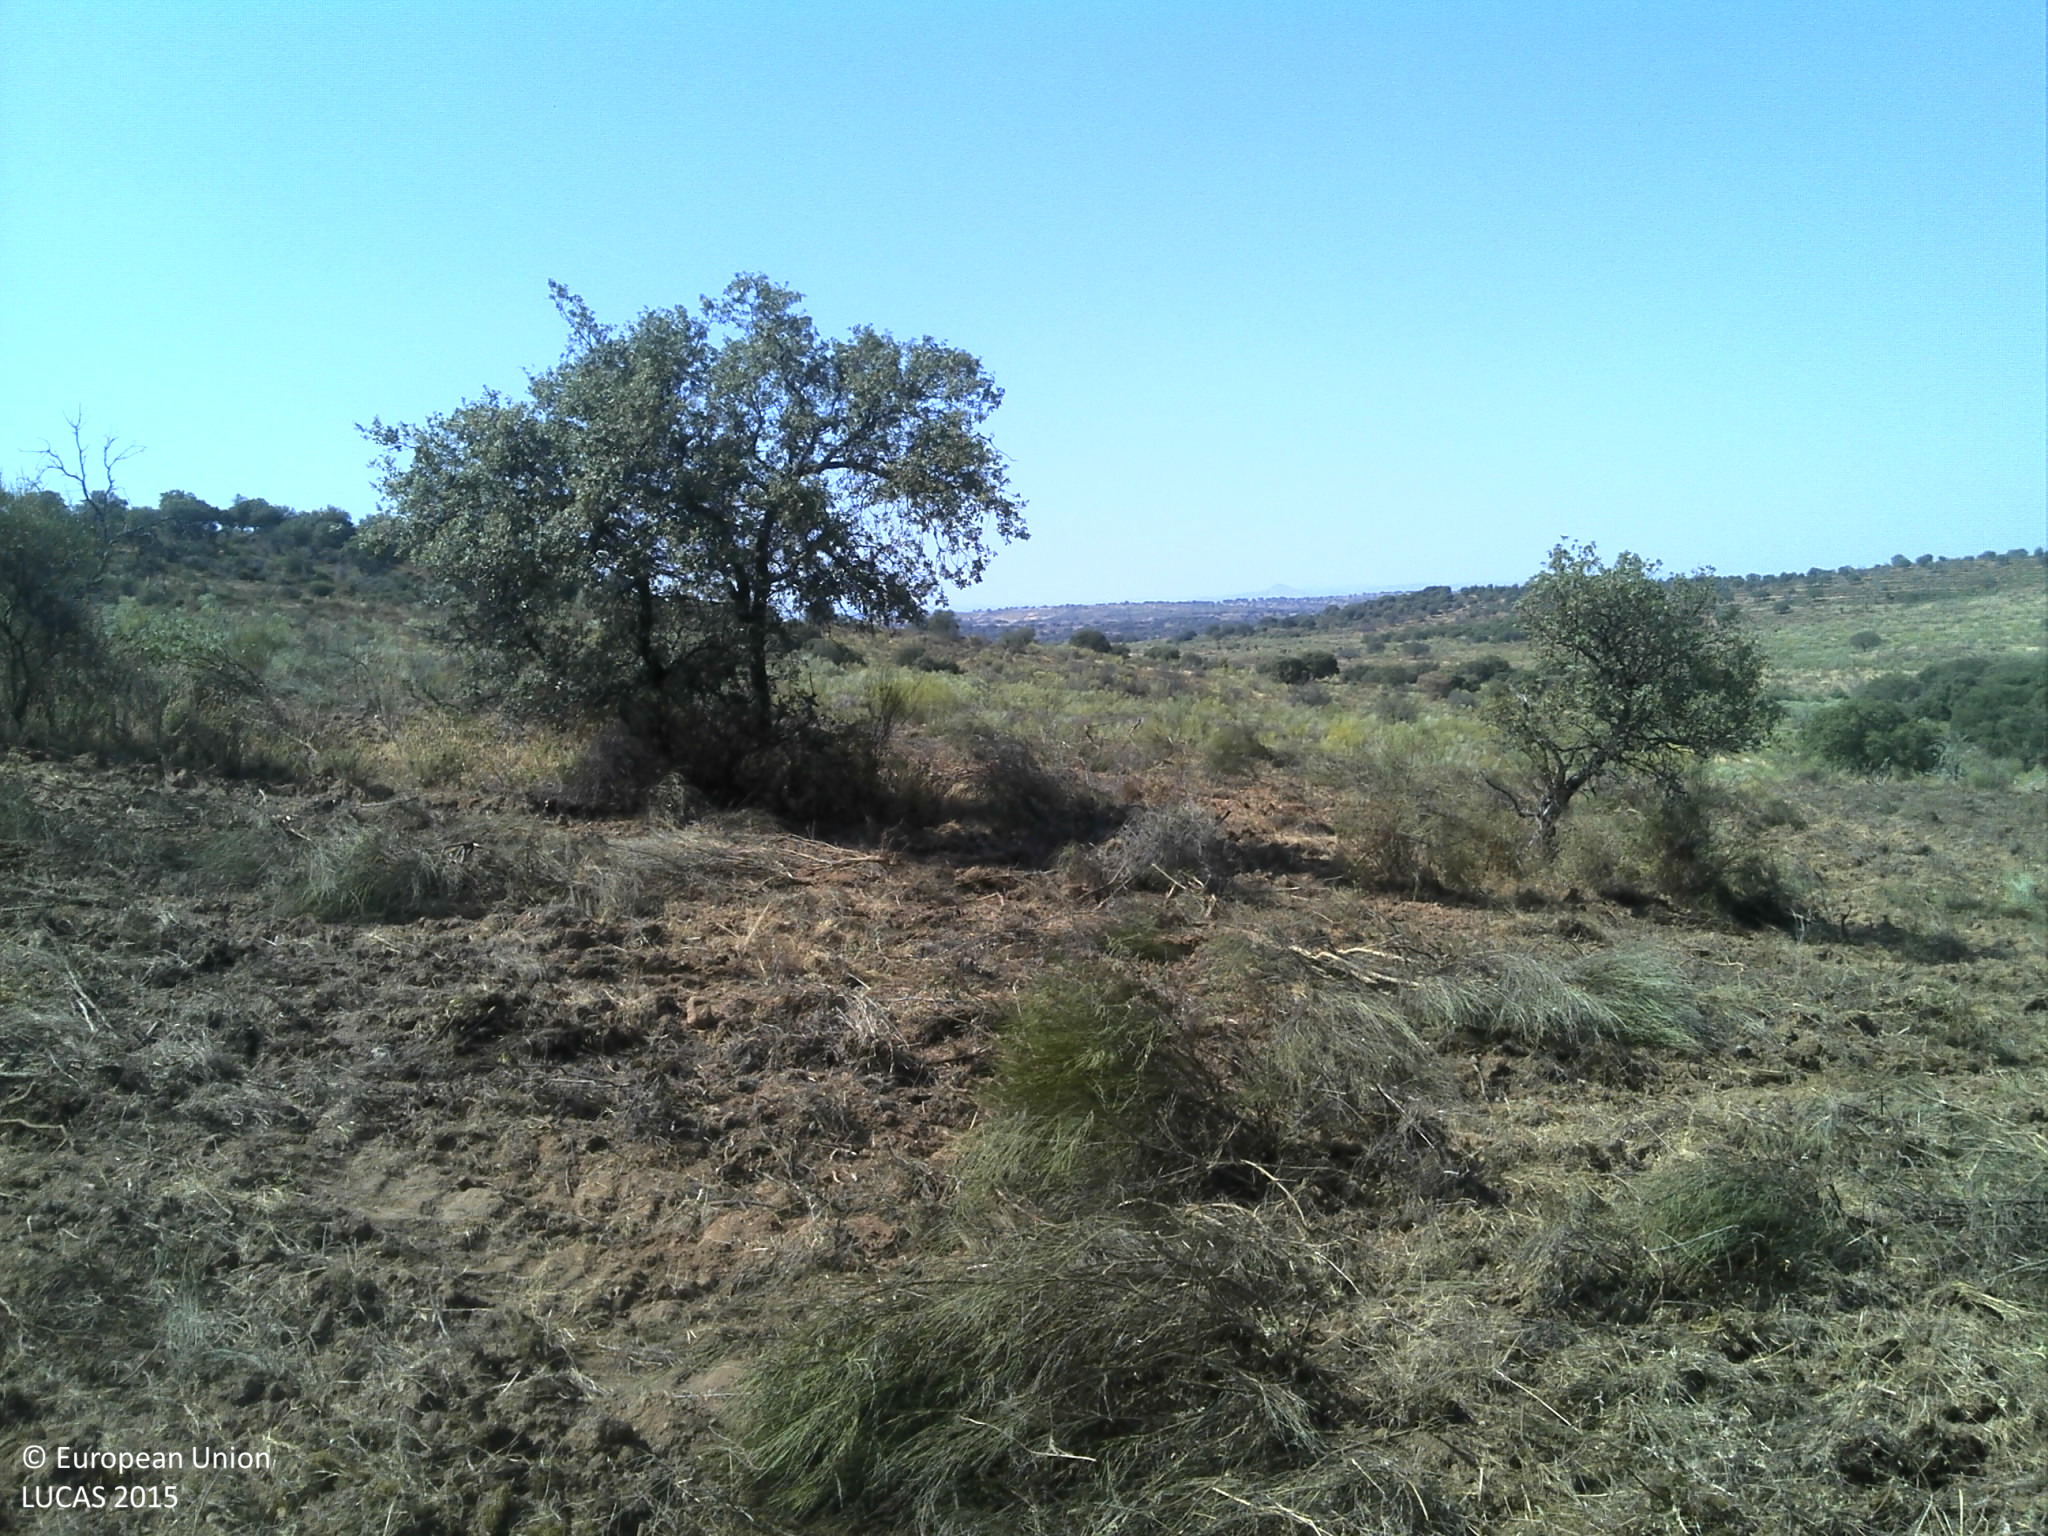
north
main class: Shrubland
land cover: Shrubland without tree cover
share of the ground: > 75 %
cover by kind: shrubs 75 %, herbaceous plants 20 %, unconsolidated bare surface 5 %
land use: Abandoned areas
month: June
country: PT
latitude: 39.7250
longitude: -7.1337
